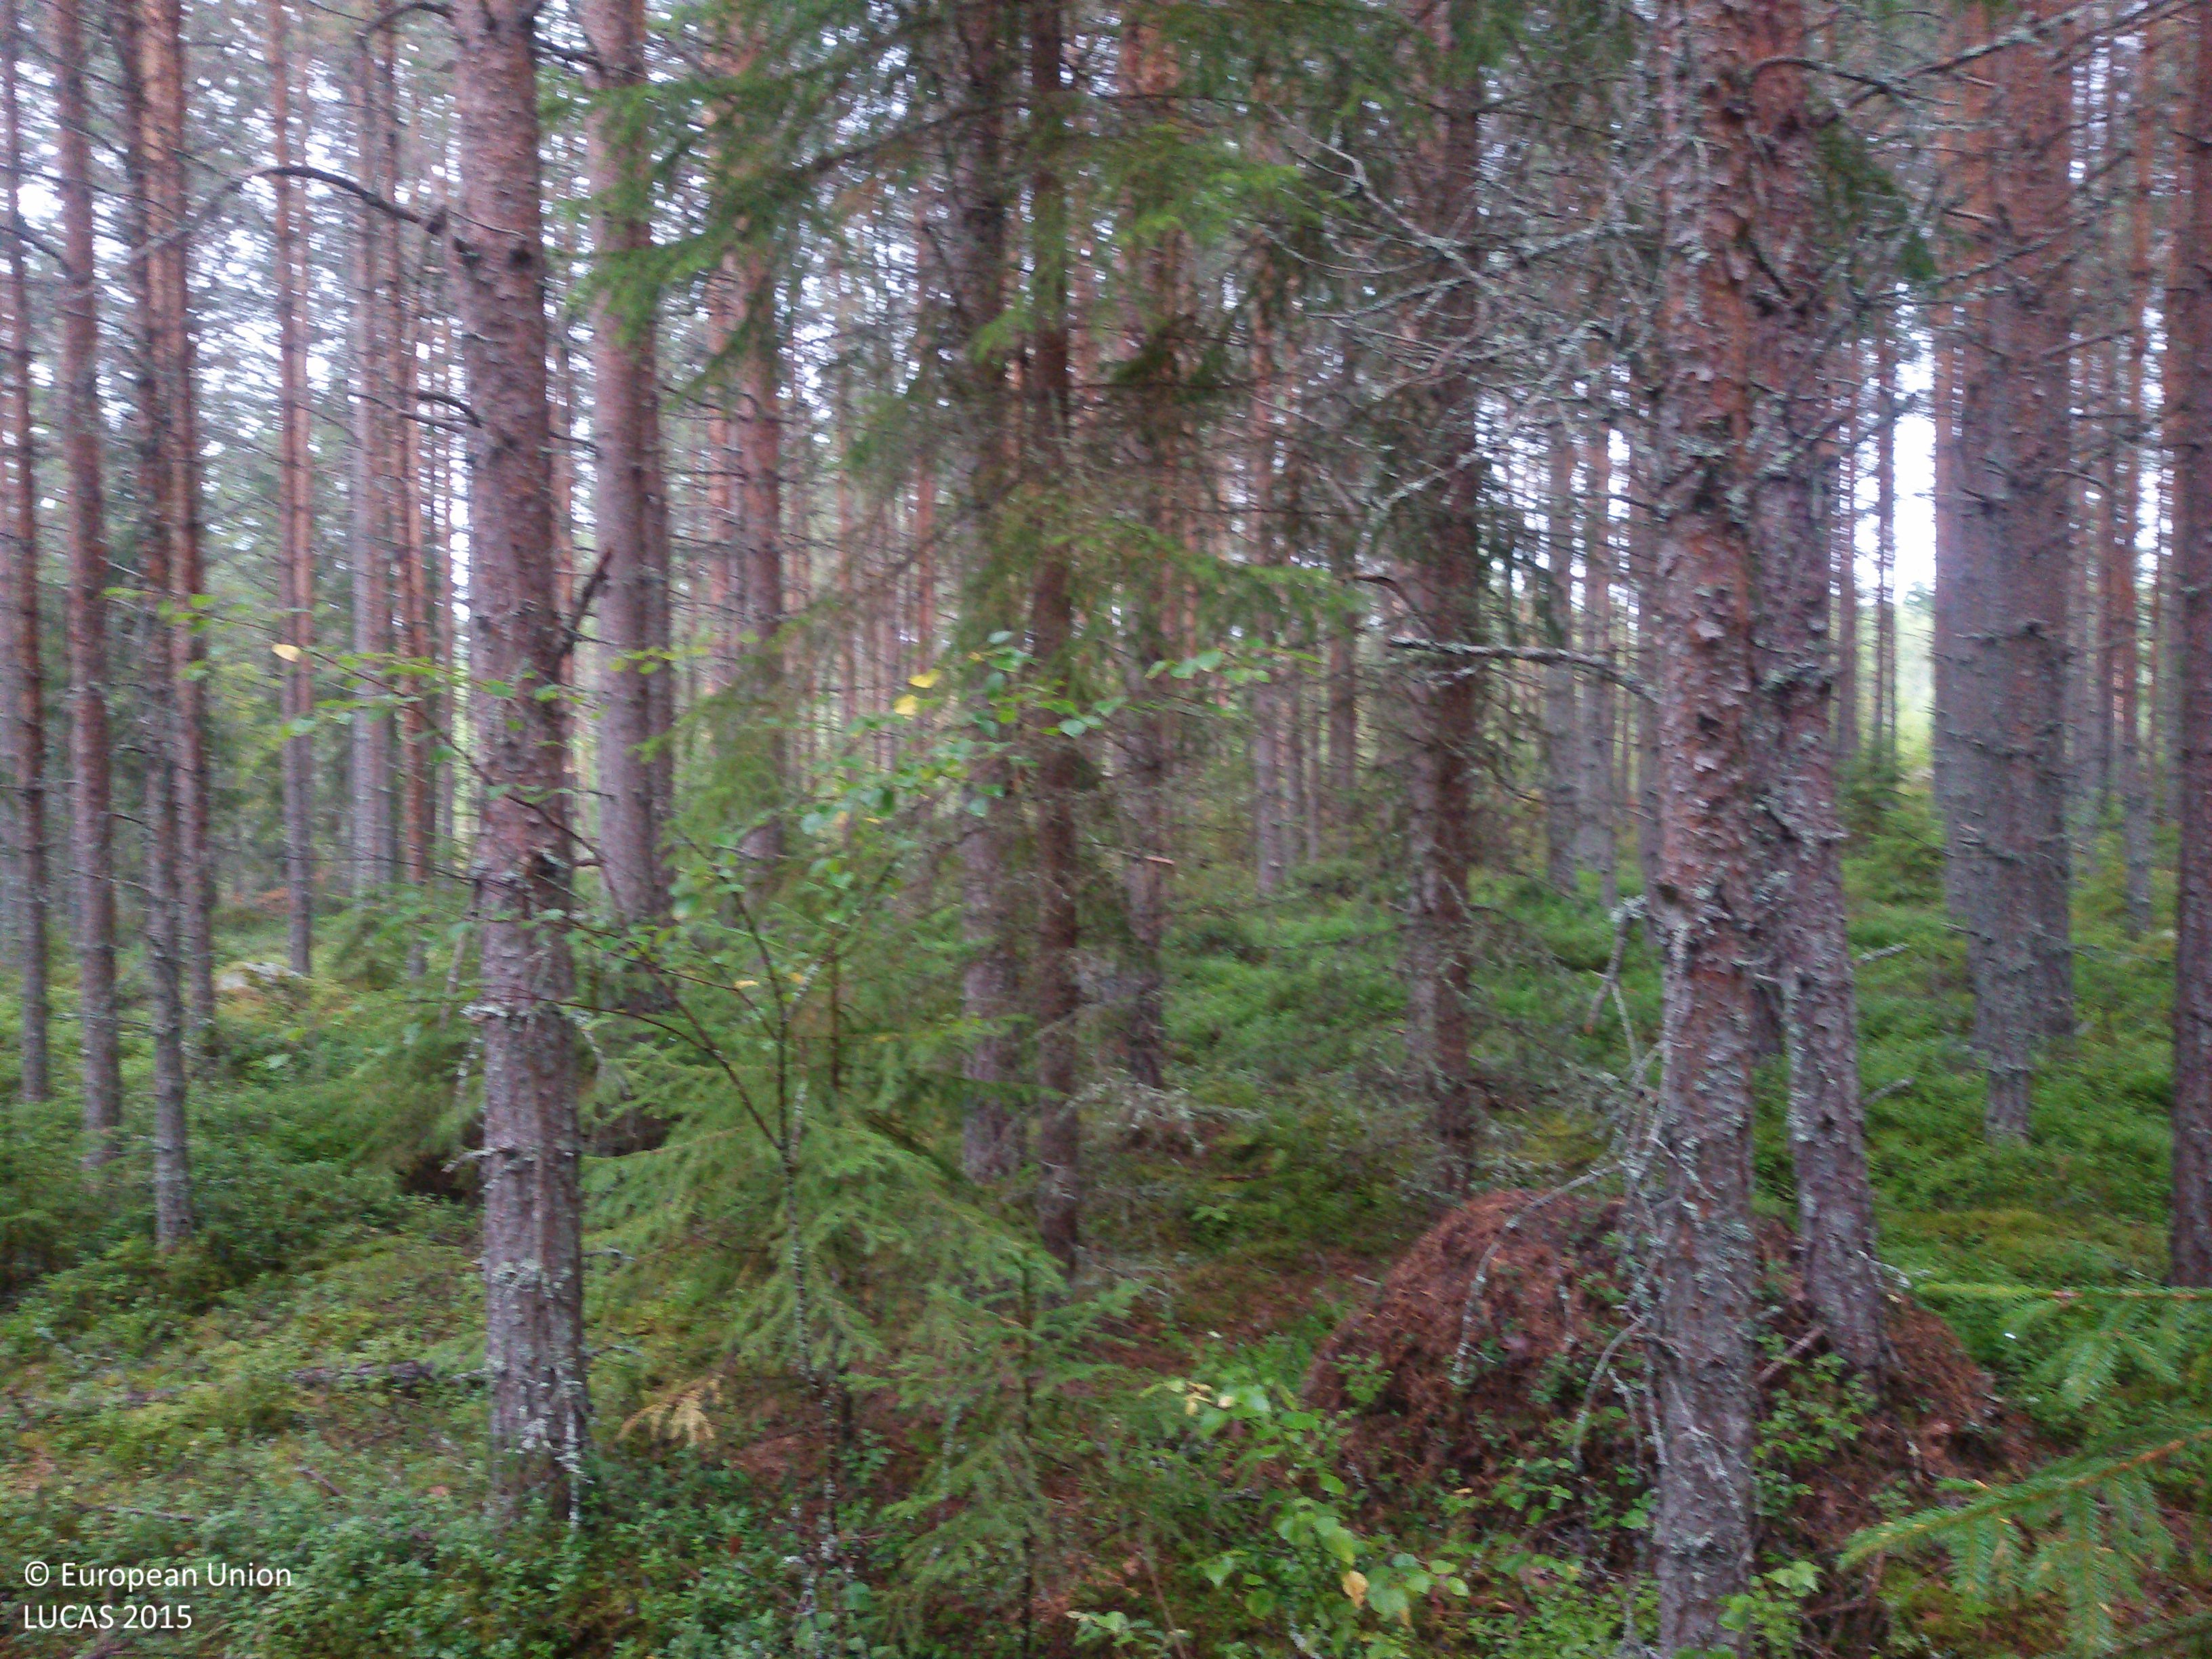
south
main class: Woodland
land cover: Pine dominated coniferous woodland
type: boreal forest
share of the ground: > 75 %
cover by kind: coniferous forest trees 85 %, shrubs 5 %, herbaceous plants 5 %, lichens and mosses 5 %
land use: Forestry
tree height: > 5 m
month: September
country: SE
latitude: 60.8222
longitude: 15.7421
